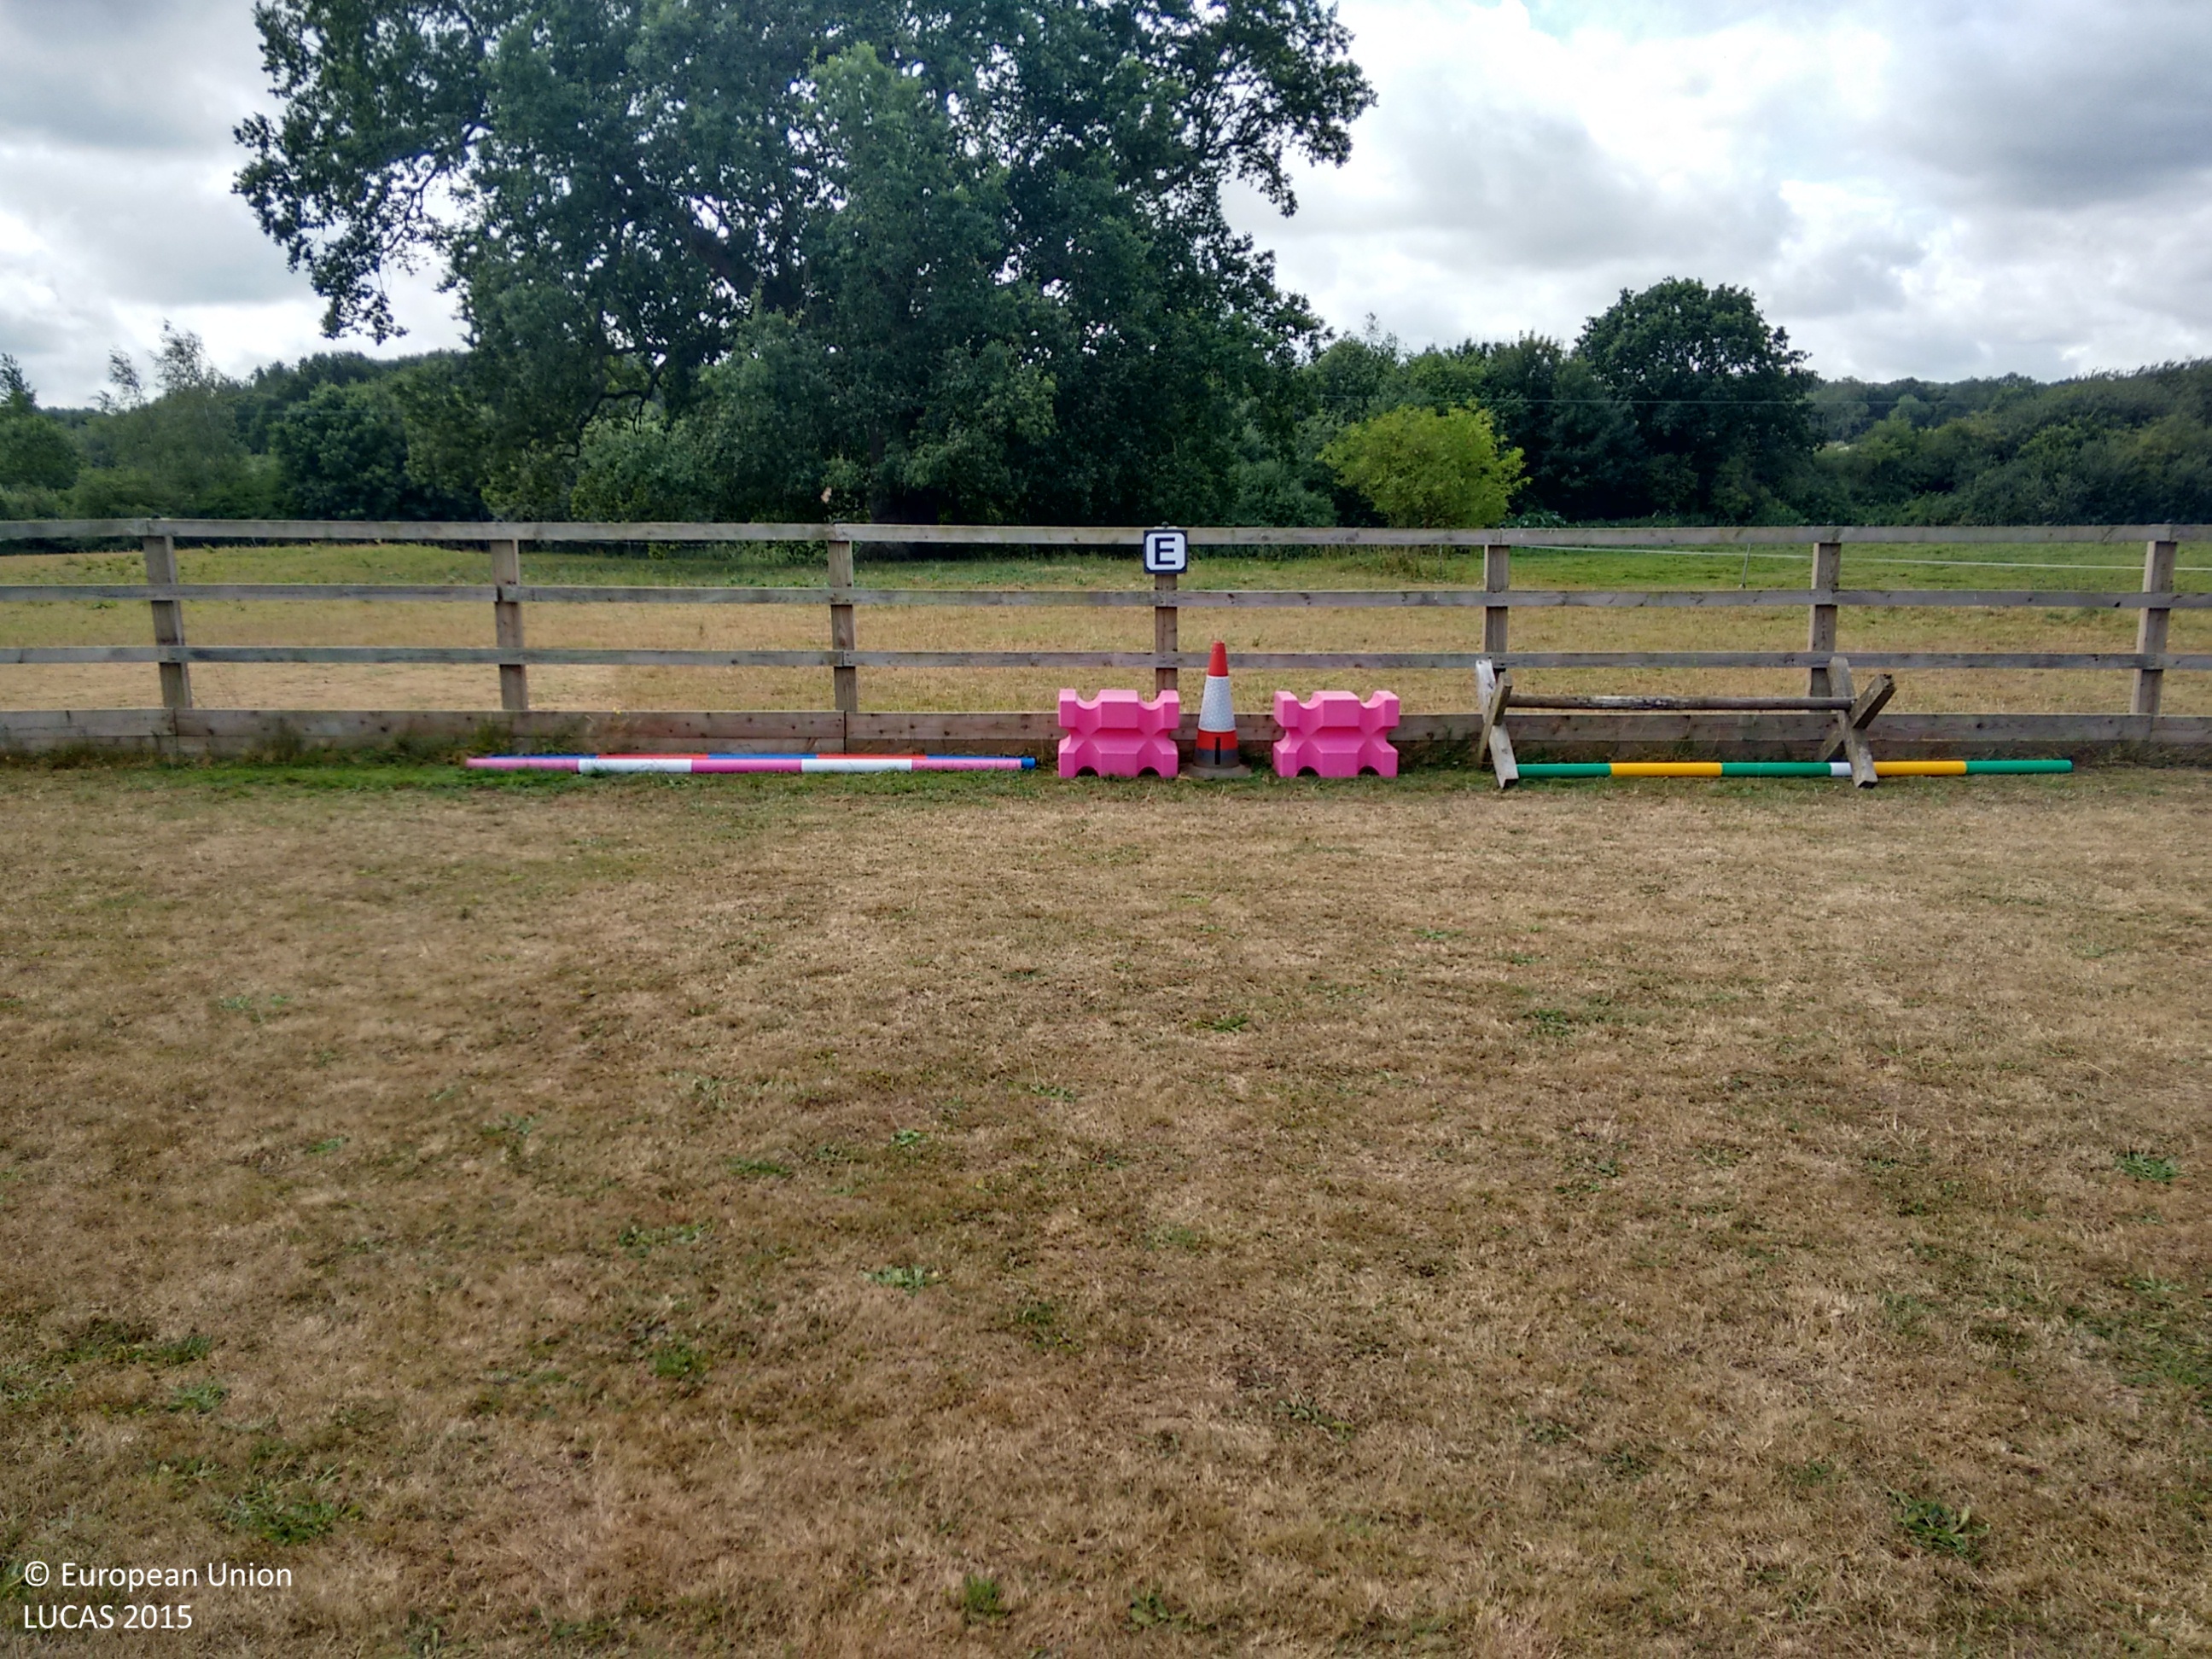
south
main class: Grassland
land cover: Grassland without tree/shrub cover
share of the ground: > 75 %
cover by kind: herbaceous plants 100 %
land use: Agriculture (excluding fallow land and kitchen gardens)
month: July
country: GB
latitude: 51.0840
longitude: -0.4157
